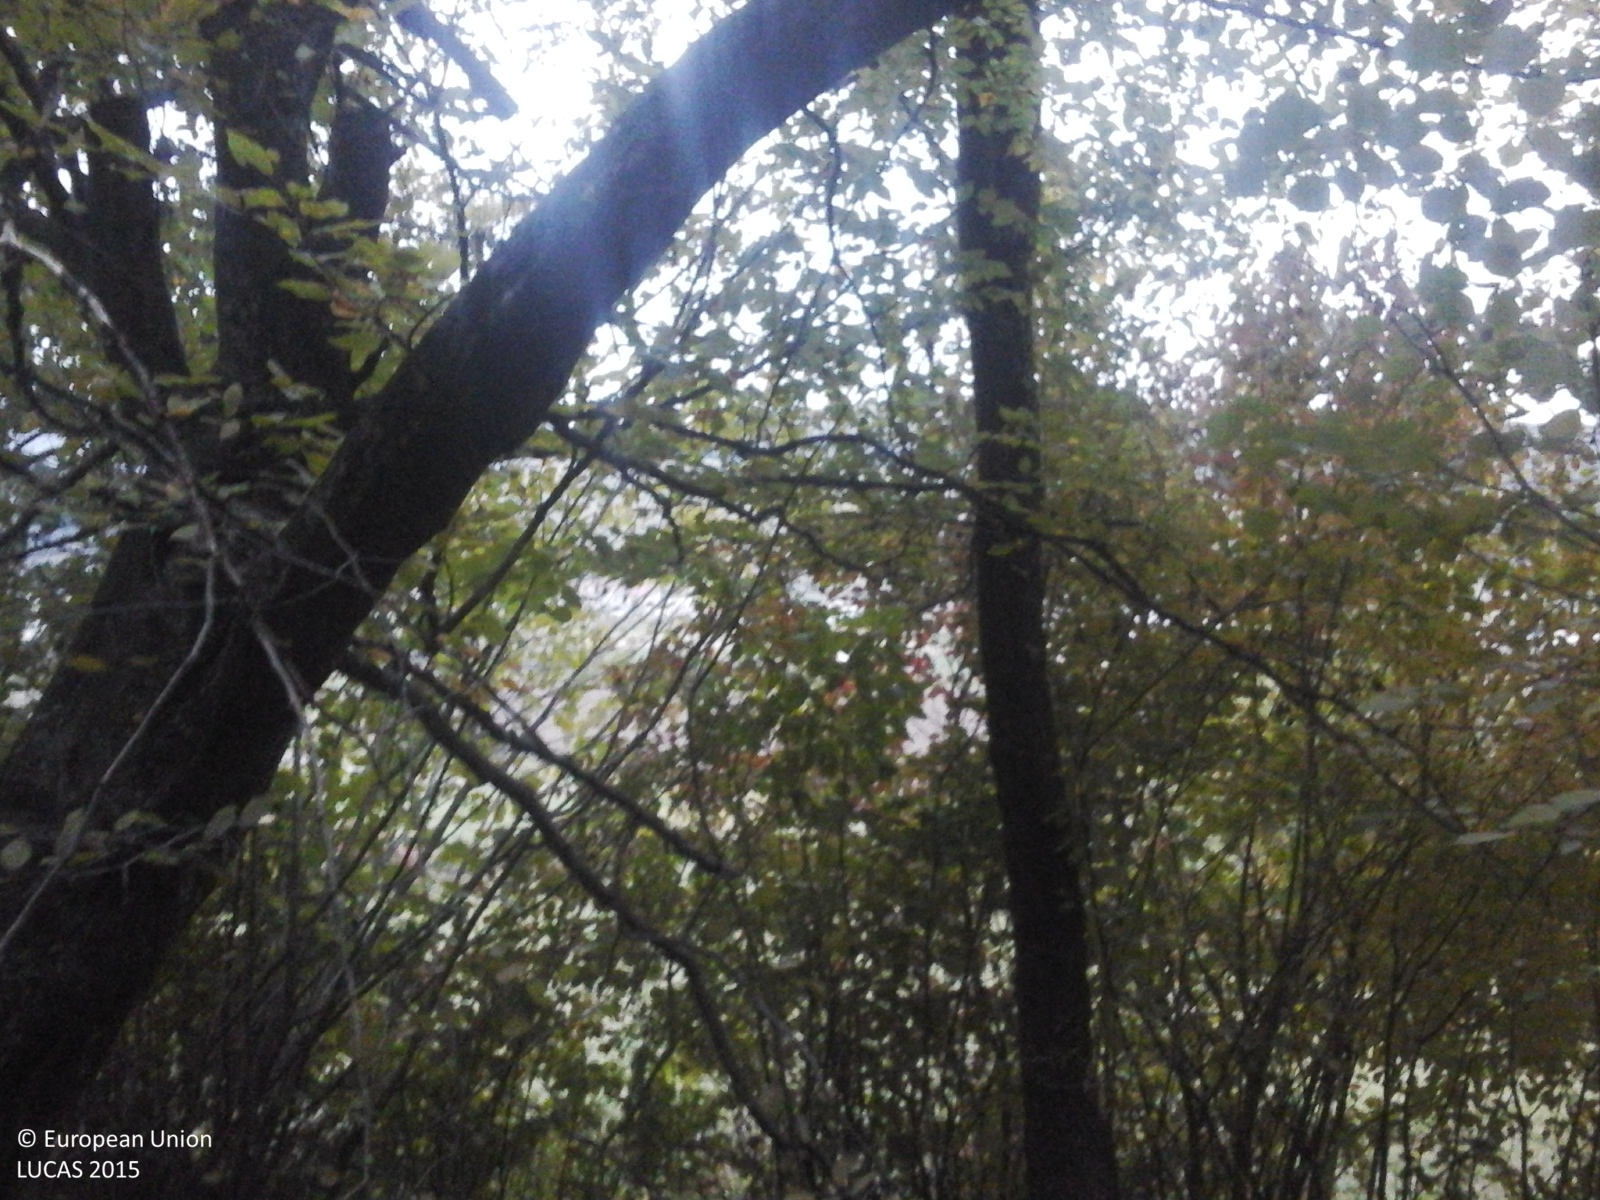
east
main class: Woodland
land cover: Broadleaved woodland
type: beech forest
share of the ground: > 75 %
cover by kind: broadleaved forest trees 100 %
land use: Forestry
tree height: > 5 m
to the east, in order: Broadleaved woodland; Grassland without tree/shrub cover; Shrubland with sparse tree cover; Grassland without tree/shrub cover; Tracks; Grassland without tree/shrub cover
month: October
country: RO
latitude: 46.2899
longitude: 25.2761
